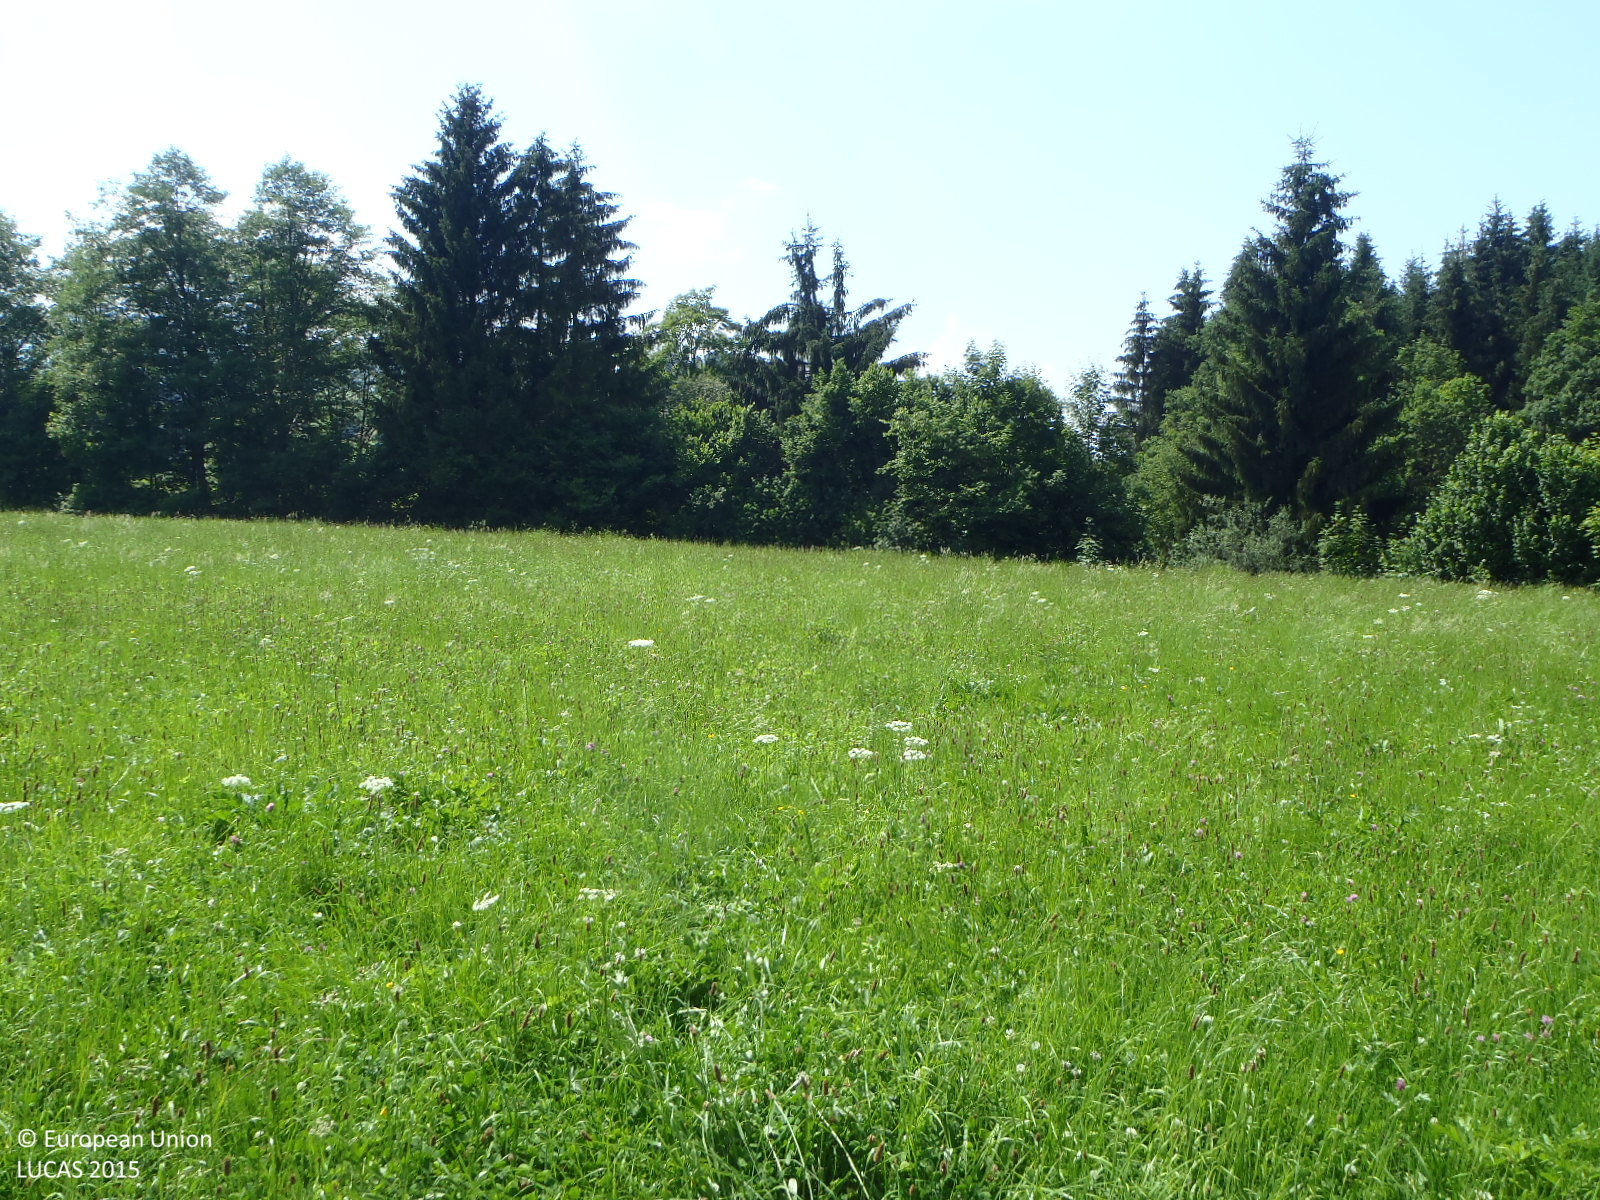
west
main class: Grassland
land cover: Grassland without tree/shrub cover
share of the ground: > 75 %
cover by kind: herbaceous plants 100 %
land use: Agriculture (excluding fallow land and kitchen gardens)
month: July
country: AT
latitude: 47.6397
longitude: 12.3811
